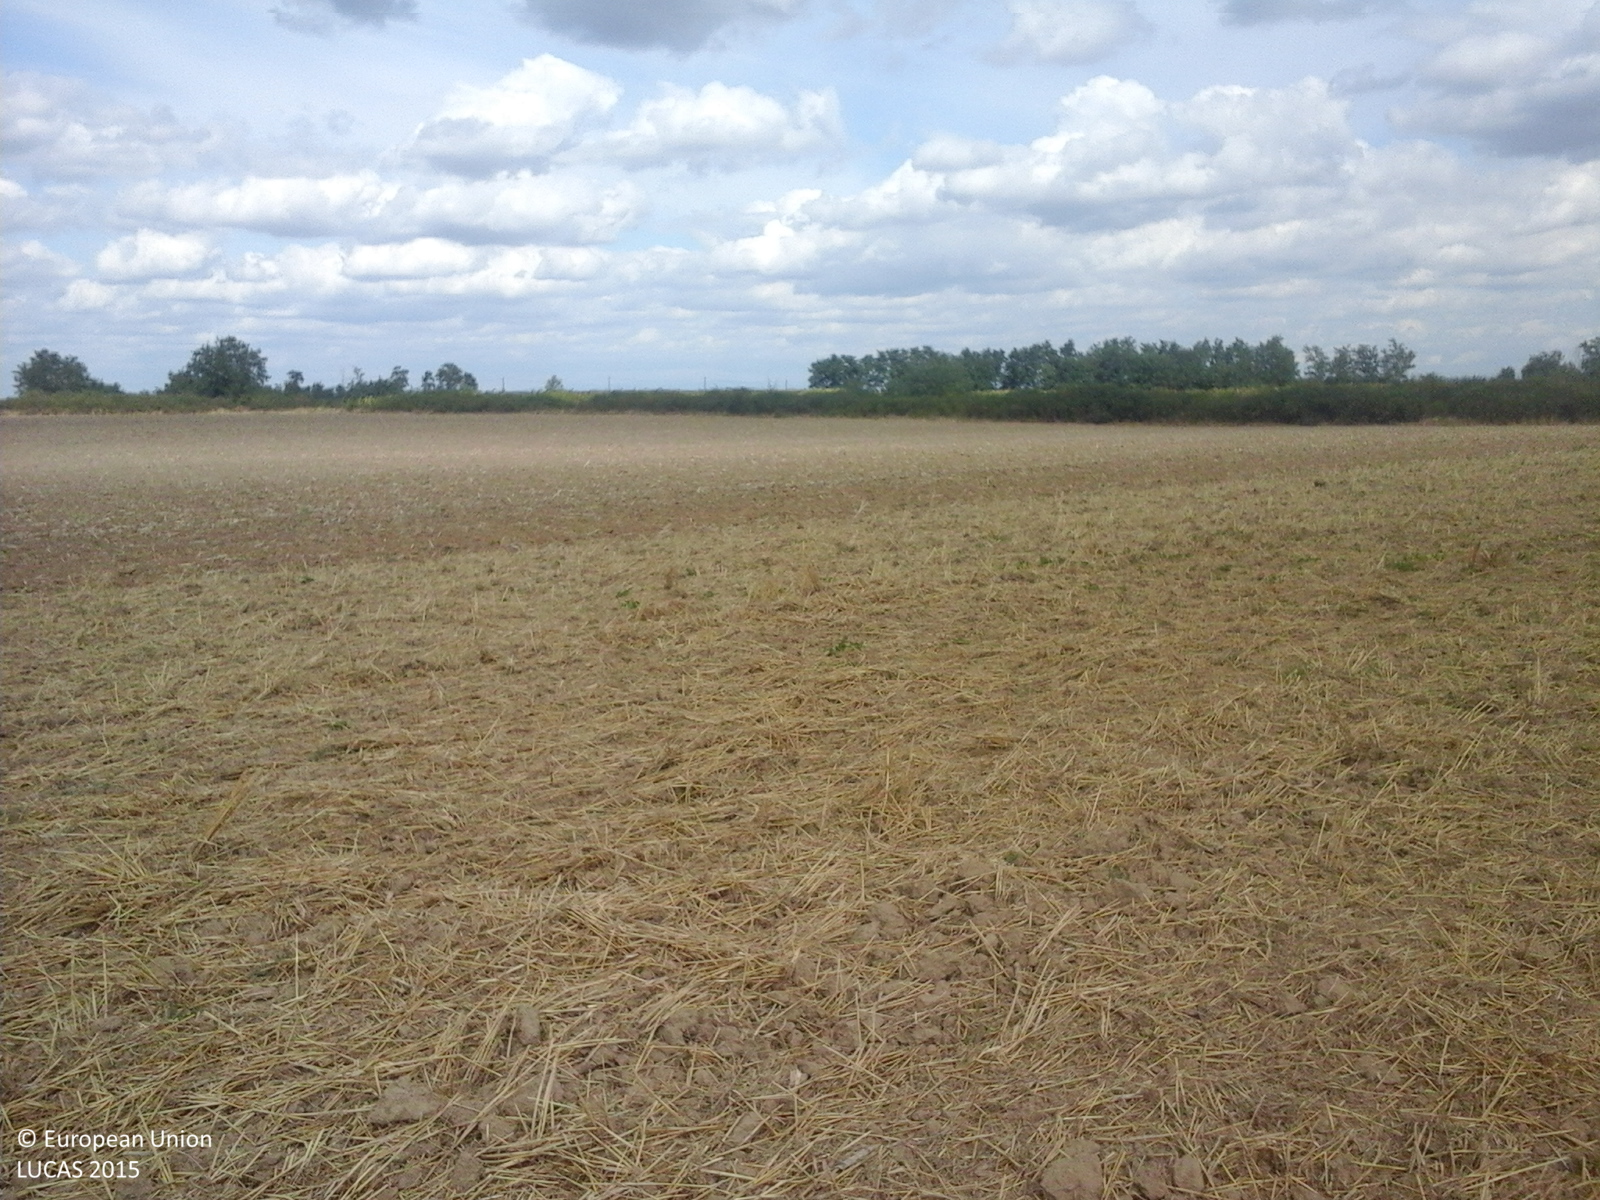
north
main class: Cropland
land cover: Common wheat
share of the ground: 25 - 50 %
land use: Agriculture (excluding fallow land and kitchen gardens)
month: September
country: RO
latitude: 47.8707
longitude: 22.8319
